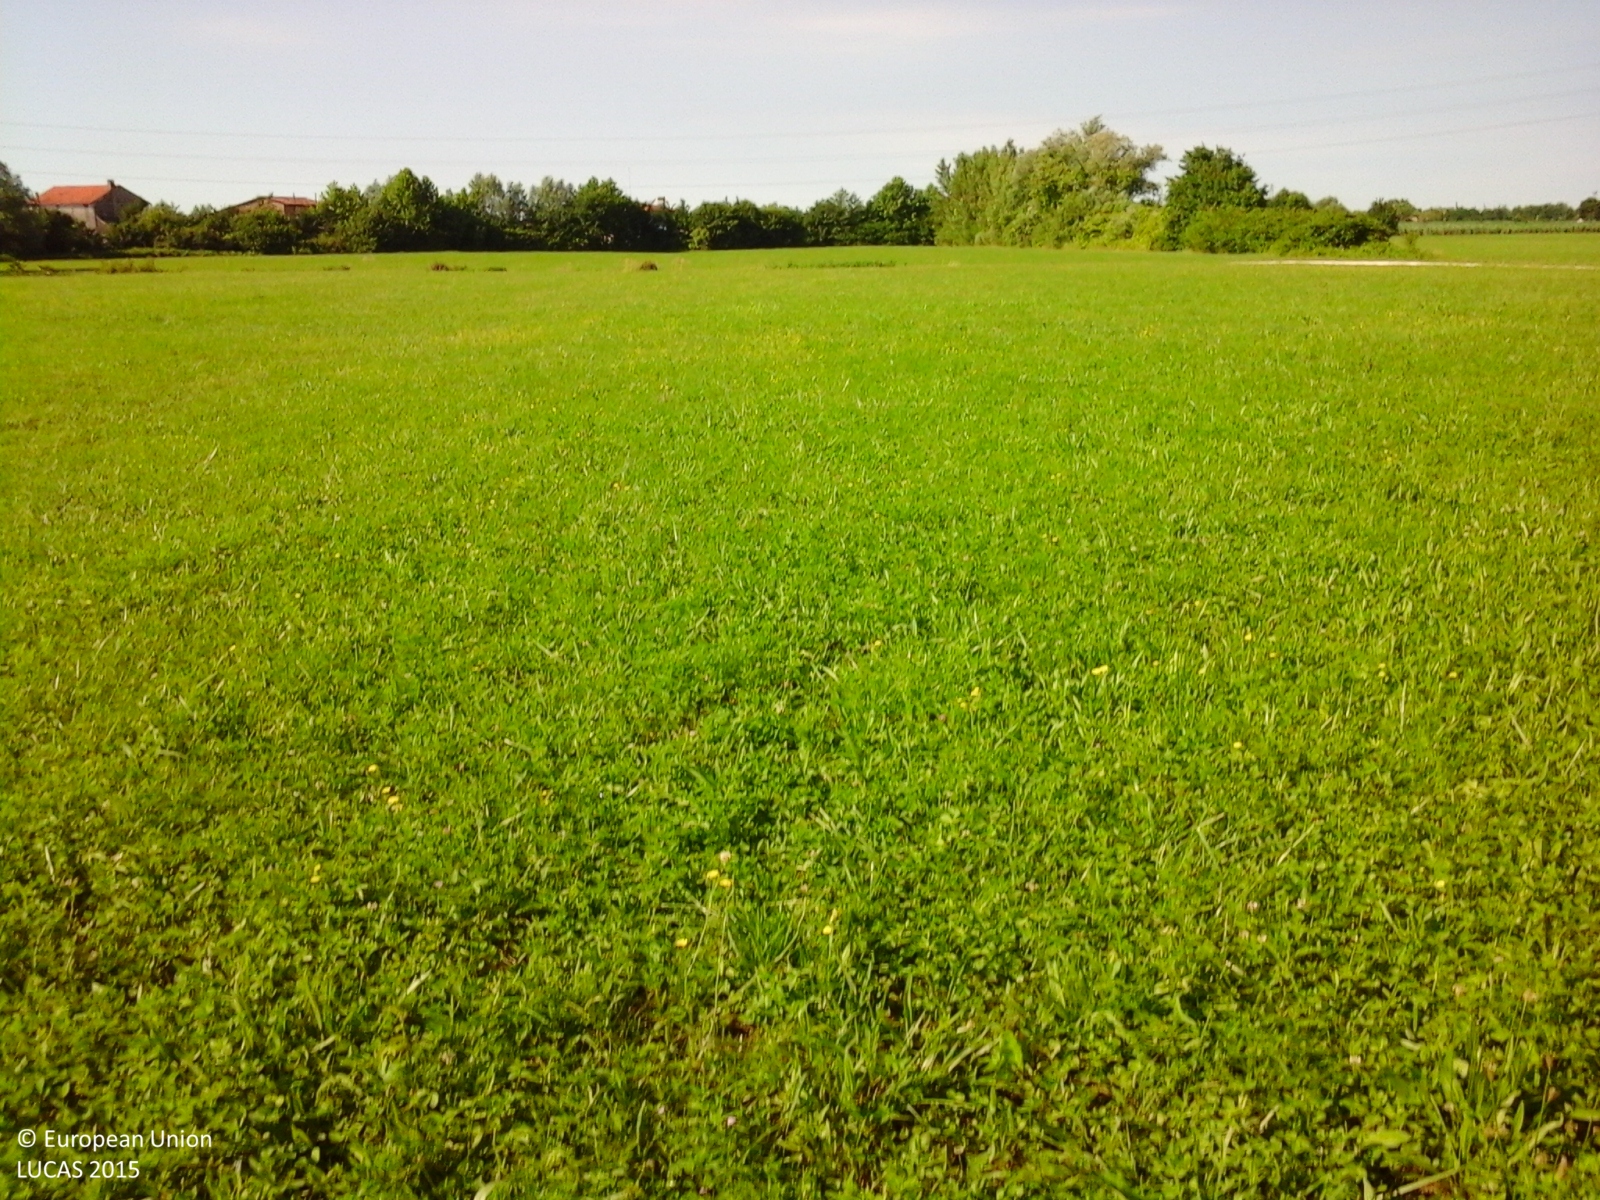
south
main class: Grassland
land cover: Grassland without tree/shrub cover
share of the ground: > 75 %
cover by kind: herbaceous plants 100 %
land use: Agriculture (excluding fallow land and kitchen gardens)
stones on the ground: < 10 %
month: June
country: IT
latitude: 45.8753
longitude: 12.3287
